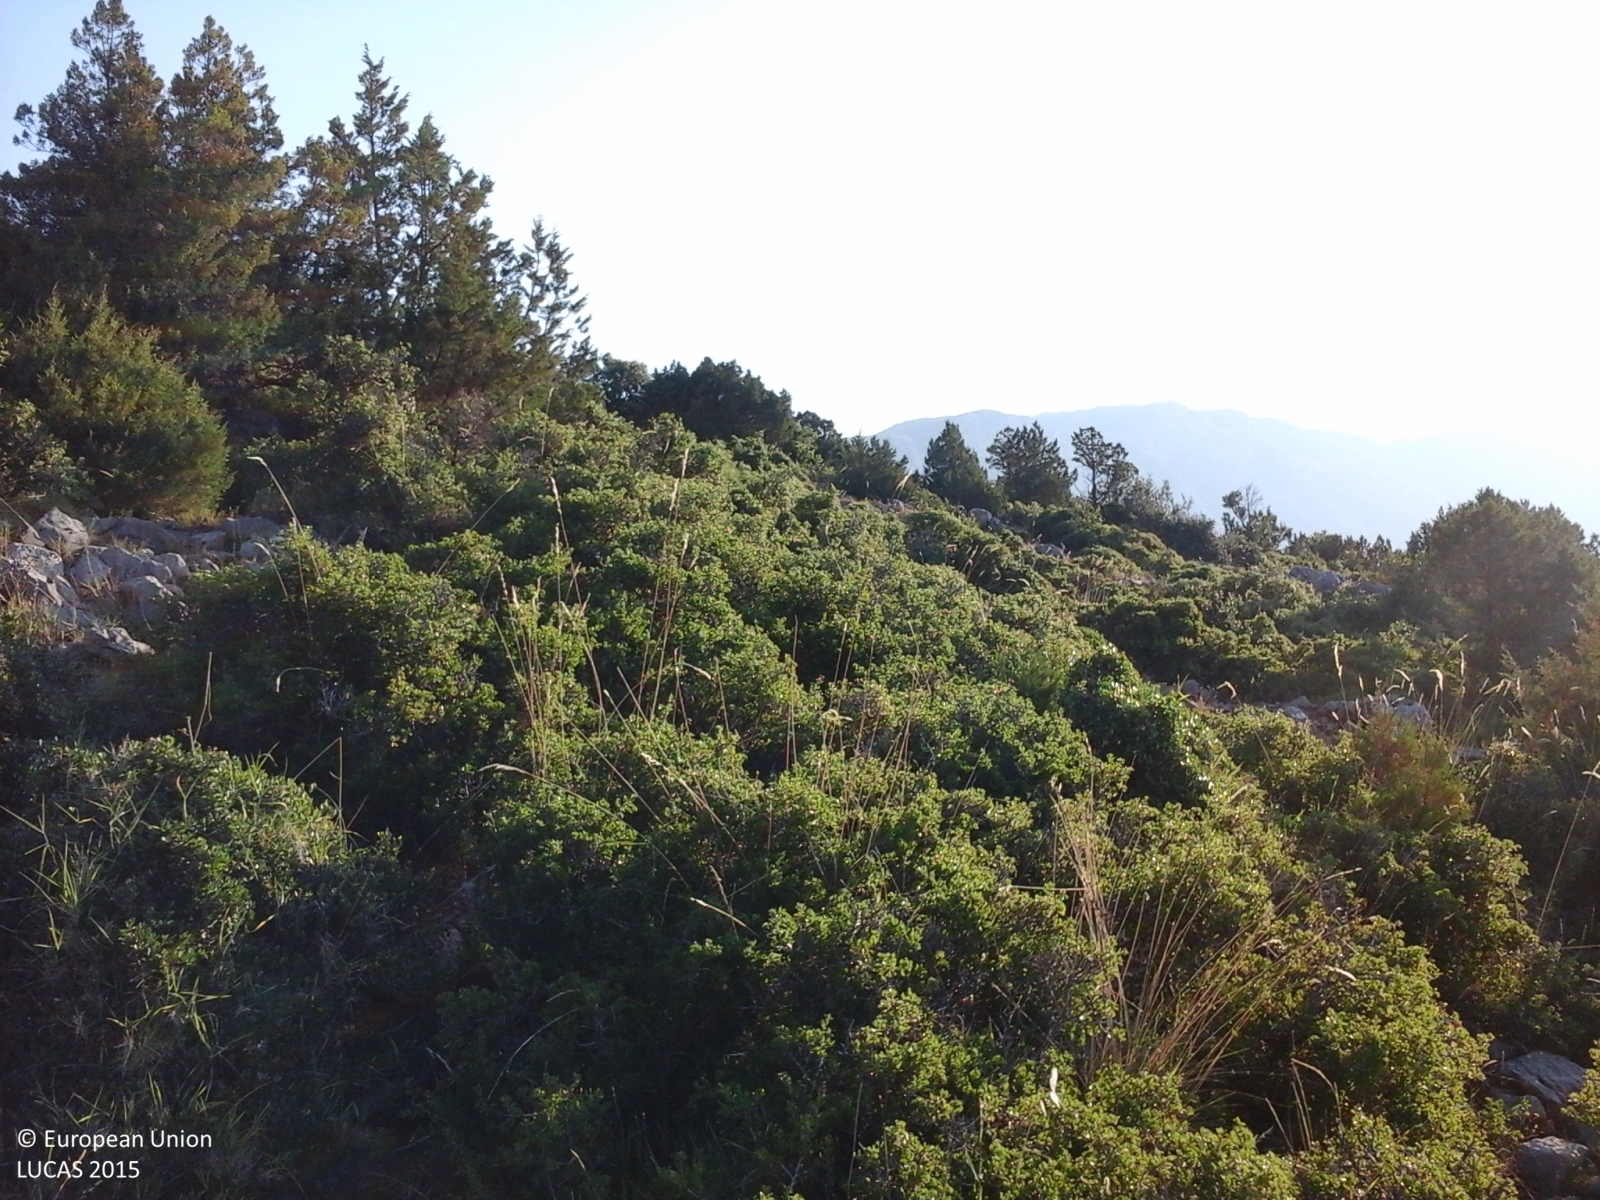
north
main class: Shrubland
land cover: Shrubland with sparse tree cover
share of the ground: > 75 %
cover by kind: shrubs 75 %, herbaceous plants 10 %, unconsolidated bare surface 10 %, coniferous forest trees 5 %
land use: Semi-natural and natural areas not in use
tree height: > 5 m
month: June
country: GR
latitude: 38.4580
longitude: 22.5010
